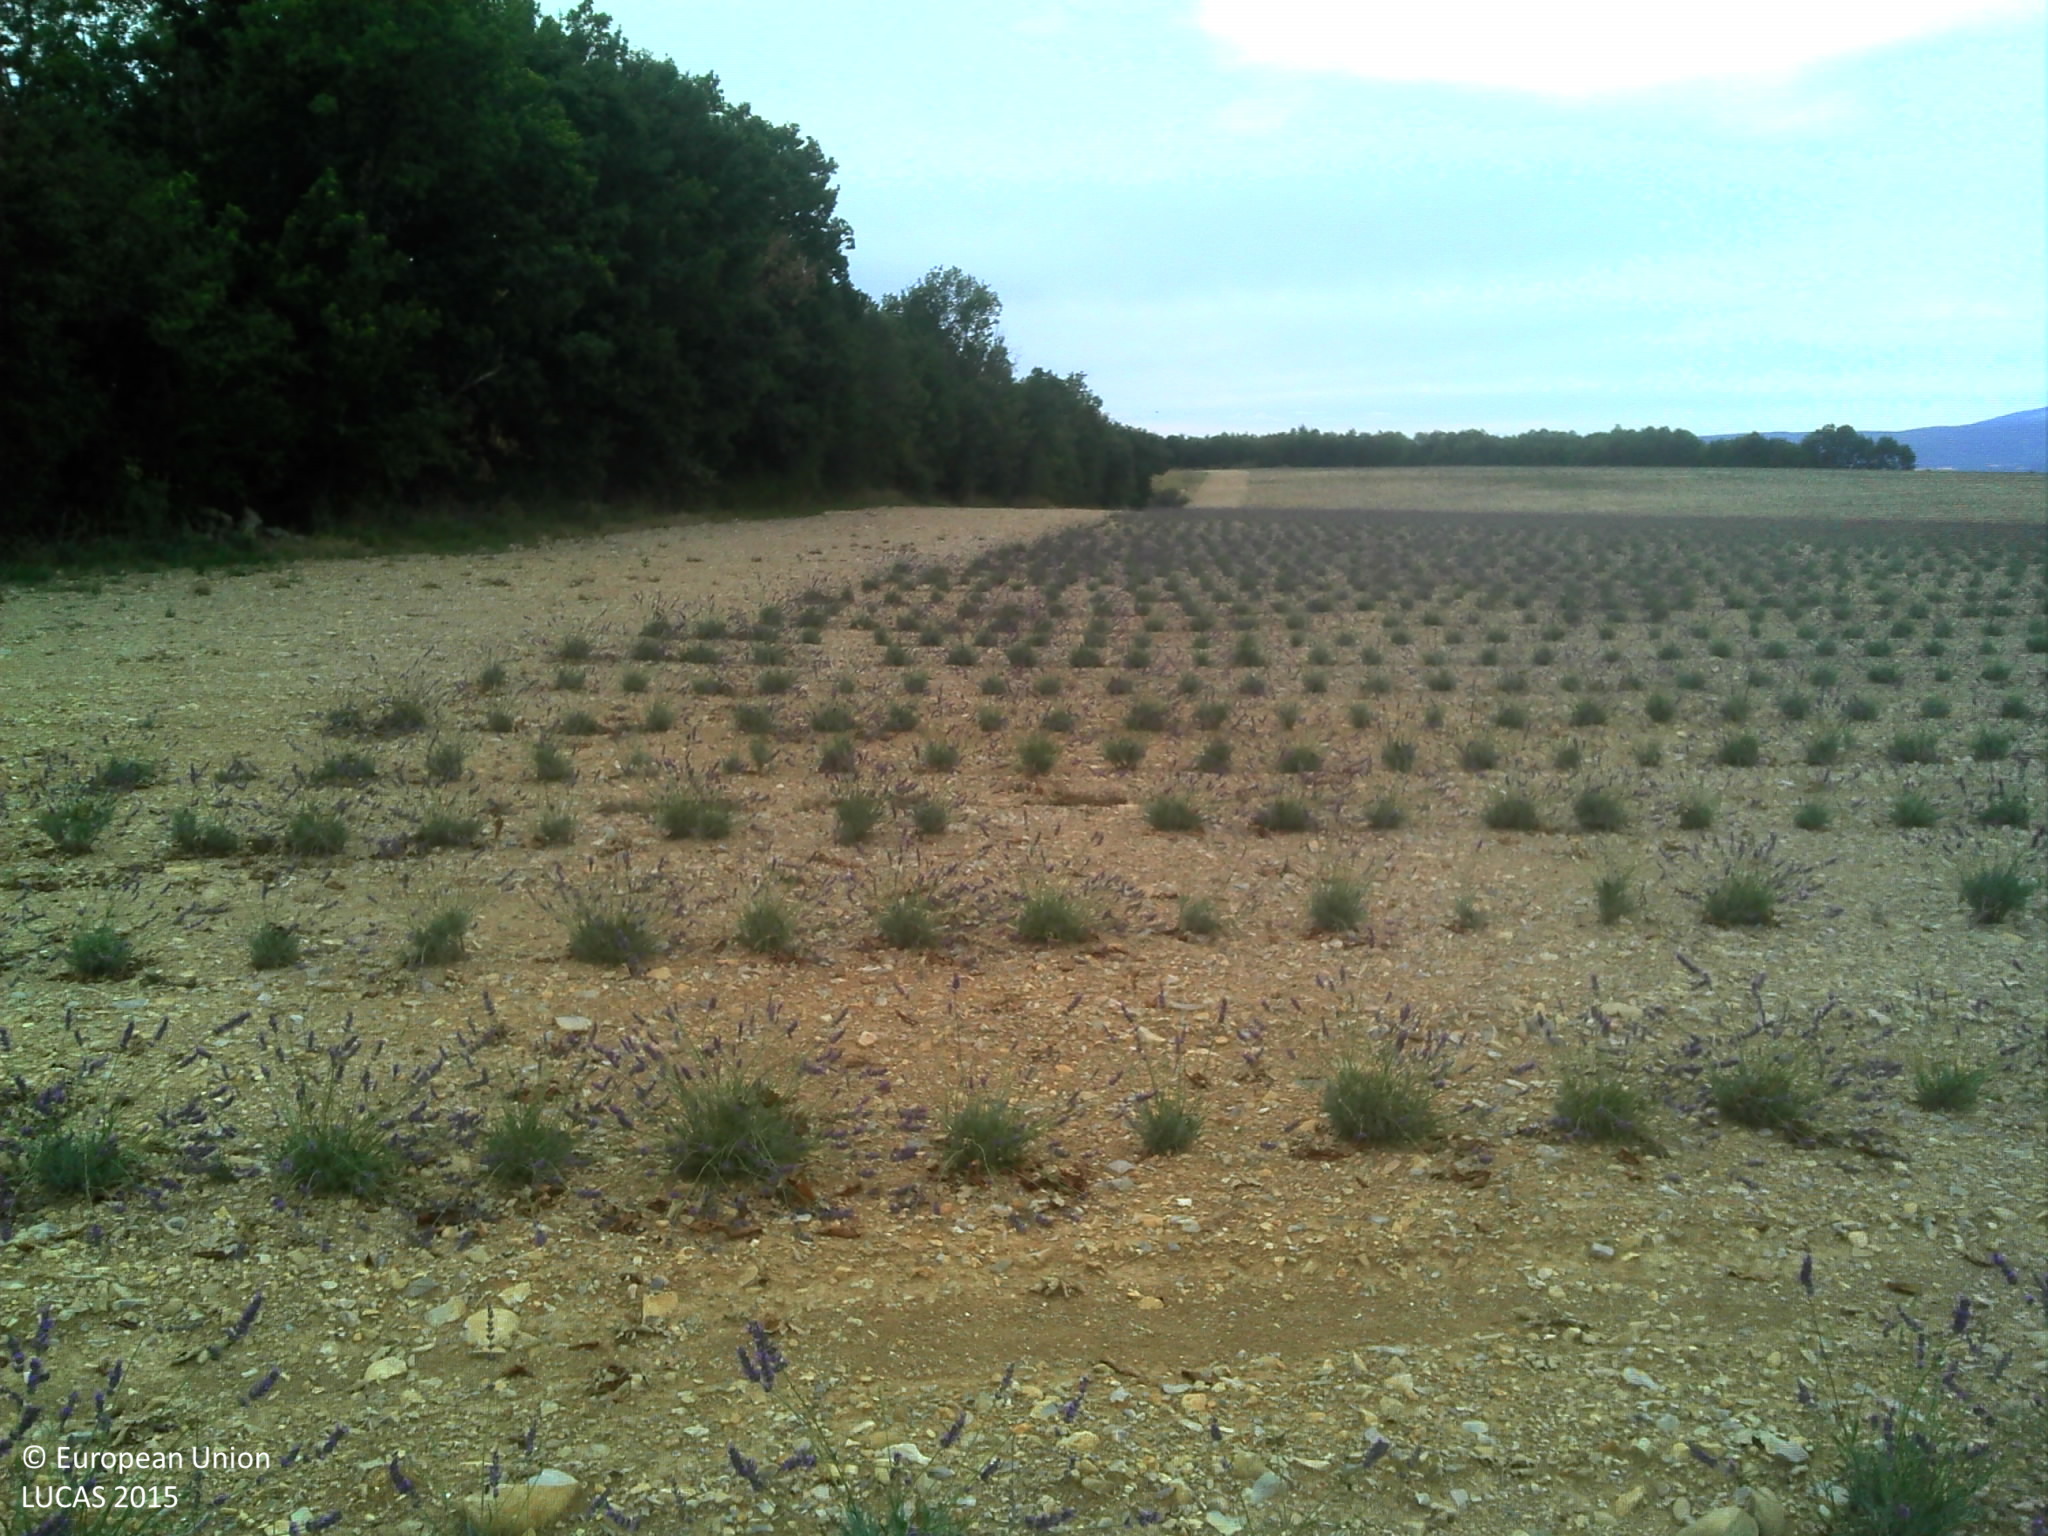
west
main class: Cropland
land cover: Permanent industrial crops
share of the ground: 10 - 25 %
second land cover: Other bare soil
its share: > 75 %
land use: Agriculture (excluding fallow land and kitchen gardens)
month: July
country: FR
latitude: 44.0735
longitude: 5.5255
